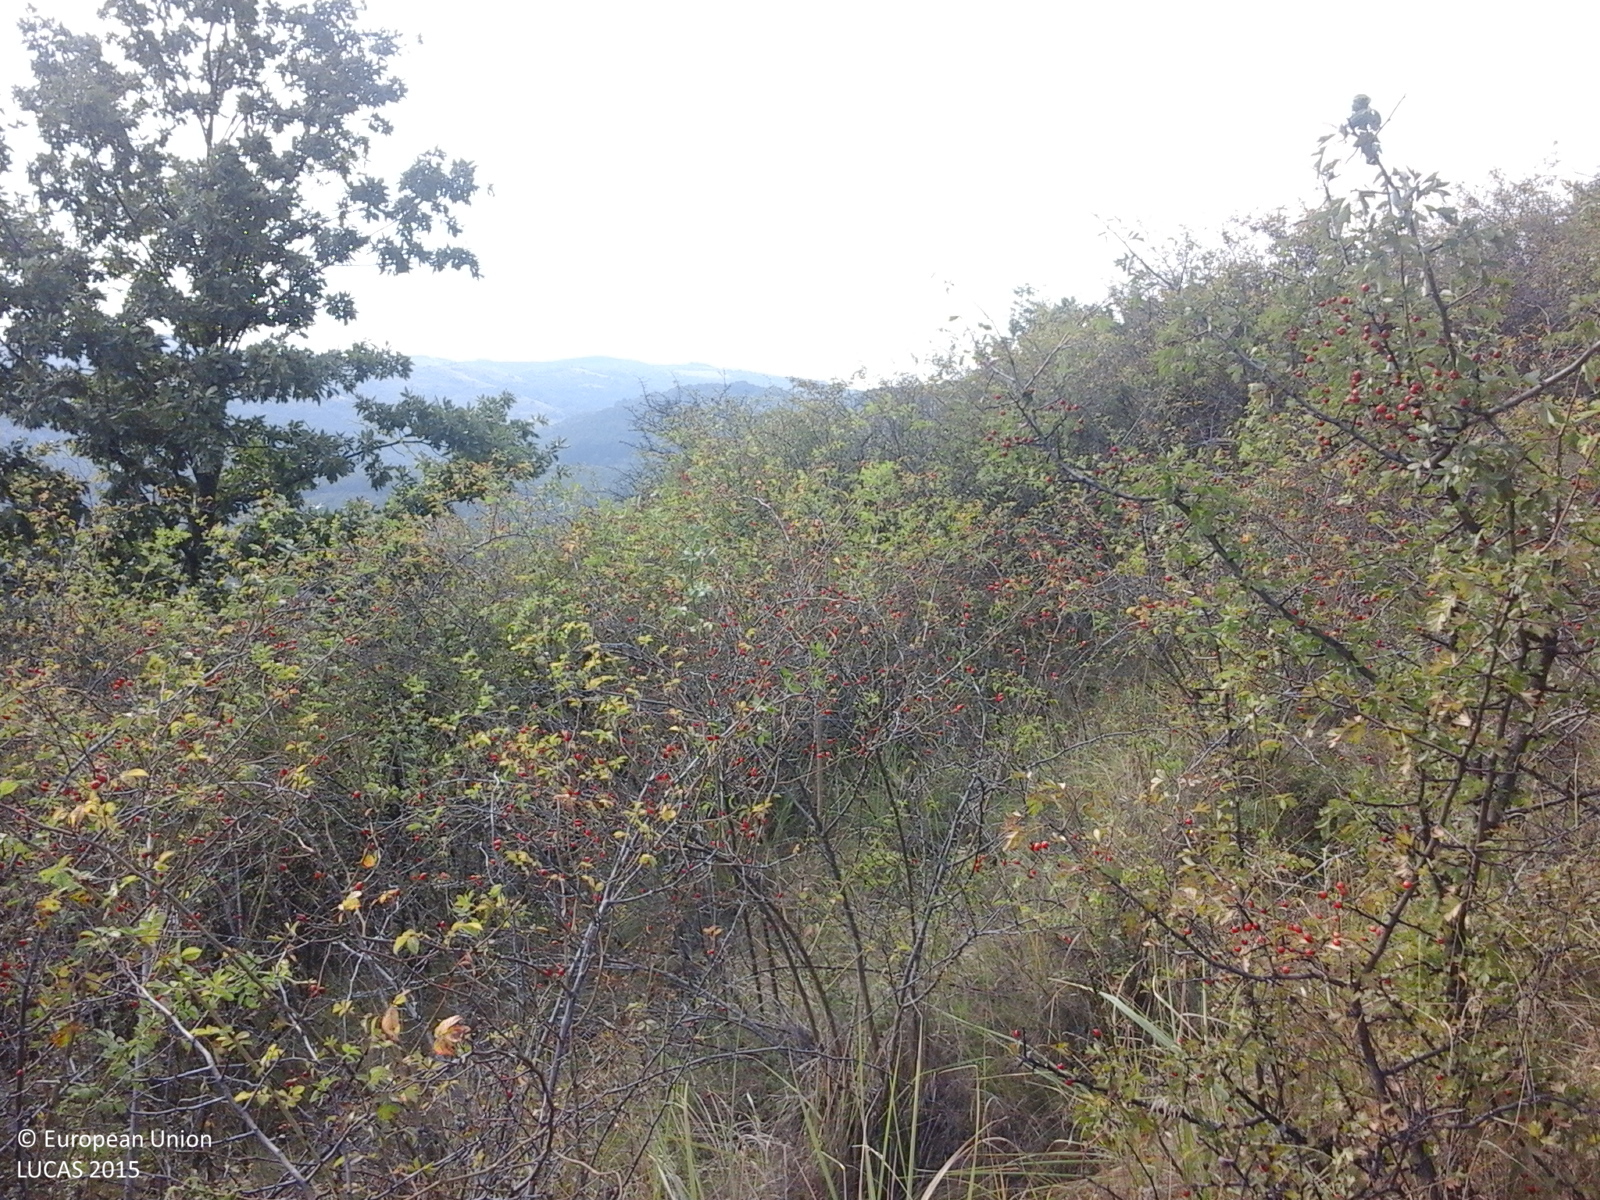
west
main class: Shrubland
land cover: Shrubland without tree cover
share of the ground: > 75 %
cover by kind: shrubs 100 %
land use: Semi-natural and natural areas not in use
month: September
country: RO
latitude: 47.2074
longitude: 23.6332
